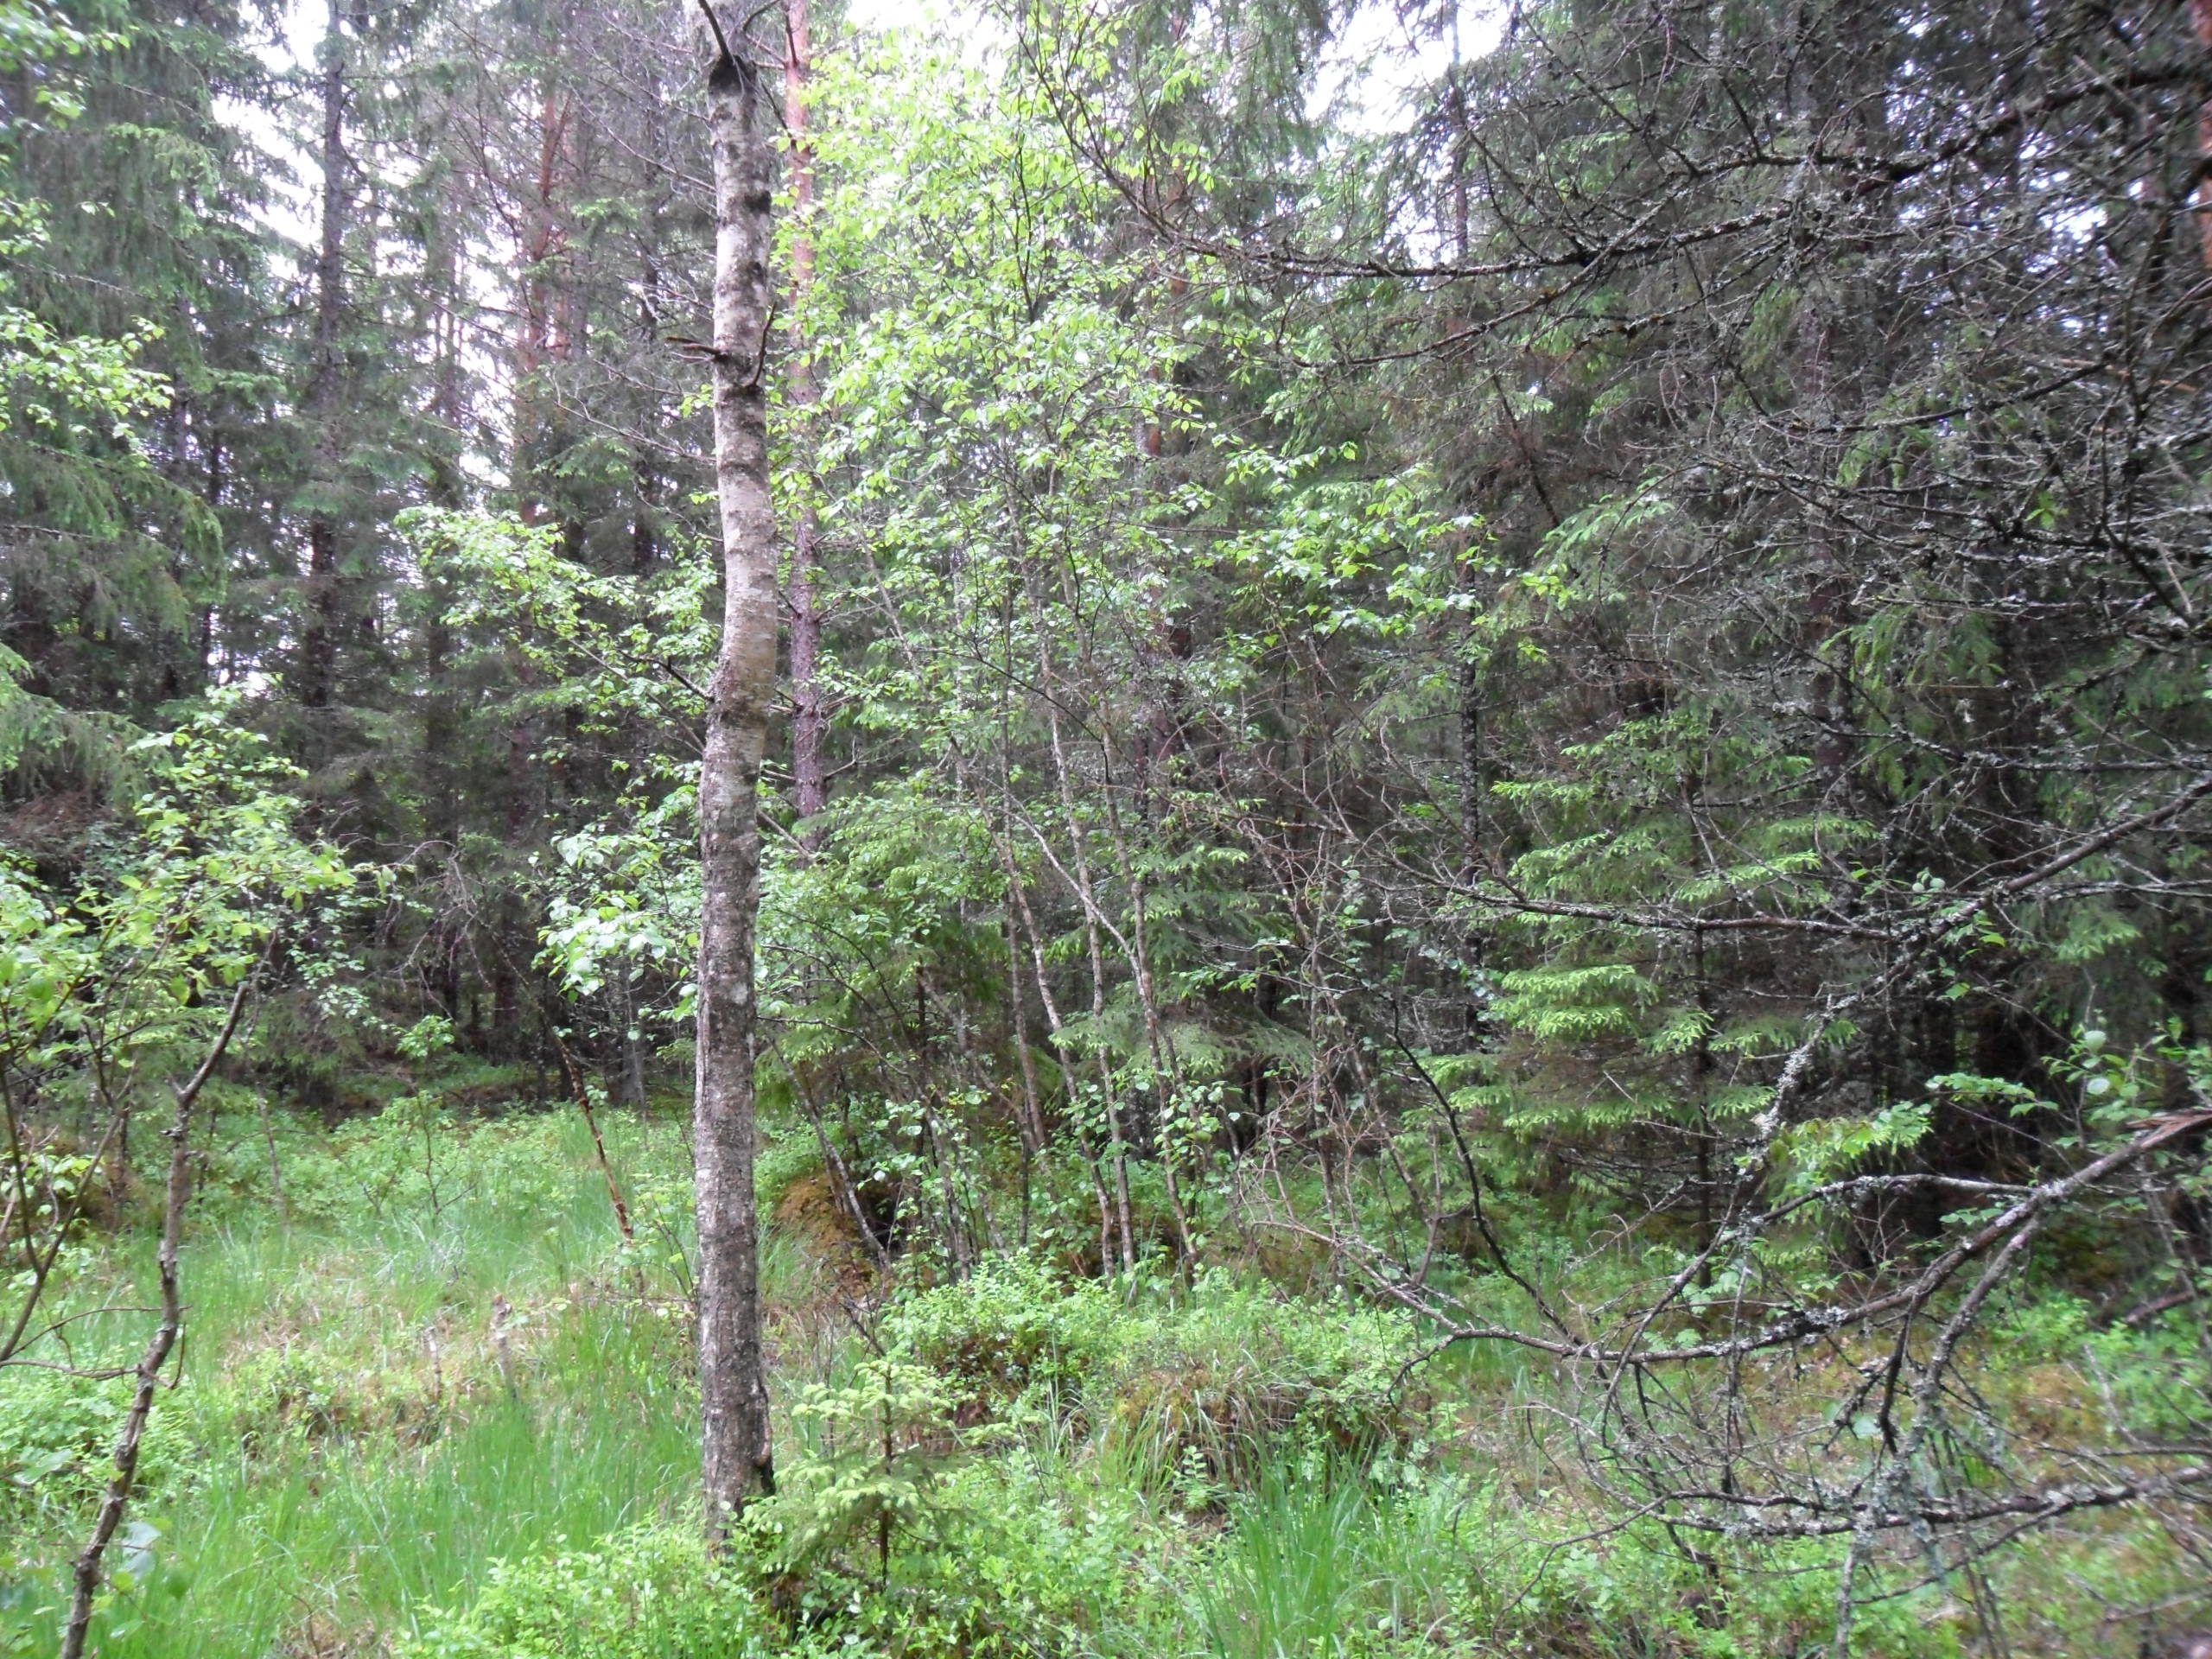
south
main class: Woodland
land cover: Spruce dominated mixed woodland
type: hemiboreal forest and nemoral coniferous forest and mixed broadleaved-coniferous forest
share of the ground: > 75 %
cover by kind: coniferous forest trees 50 %, broadleaved forest trees 30 %, herbaceous plants 20 %
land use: Forestry
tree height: > 5 m
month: June
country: LV
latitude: 57.4077
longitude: 22.1826
